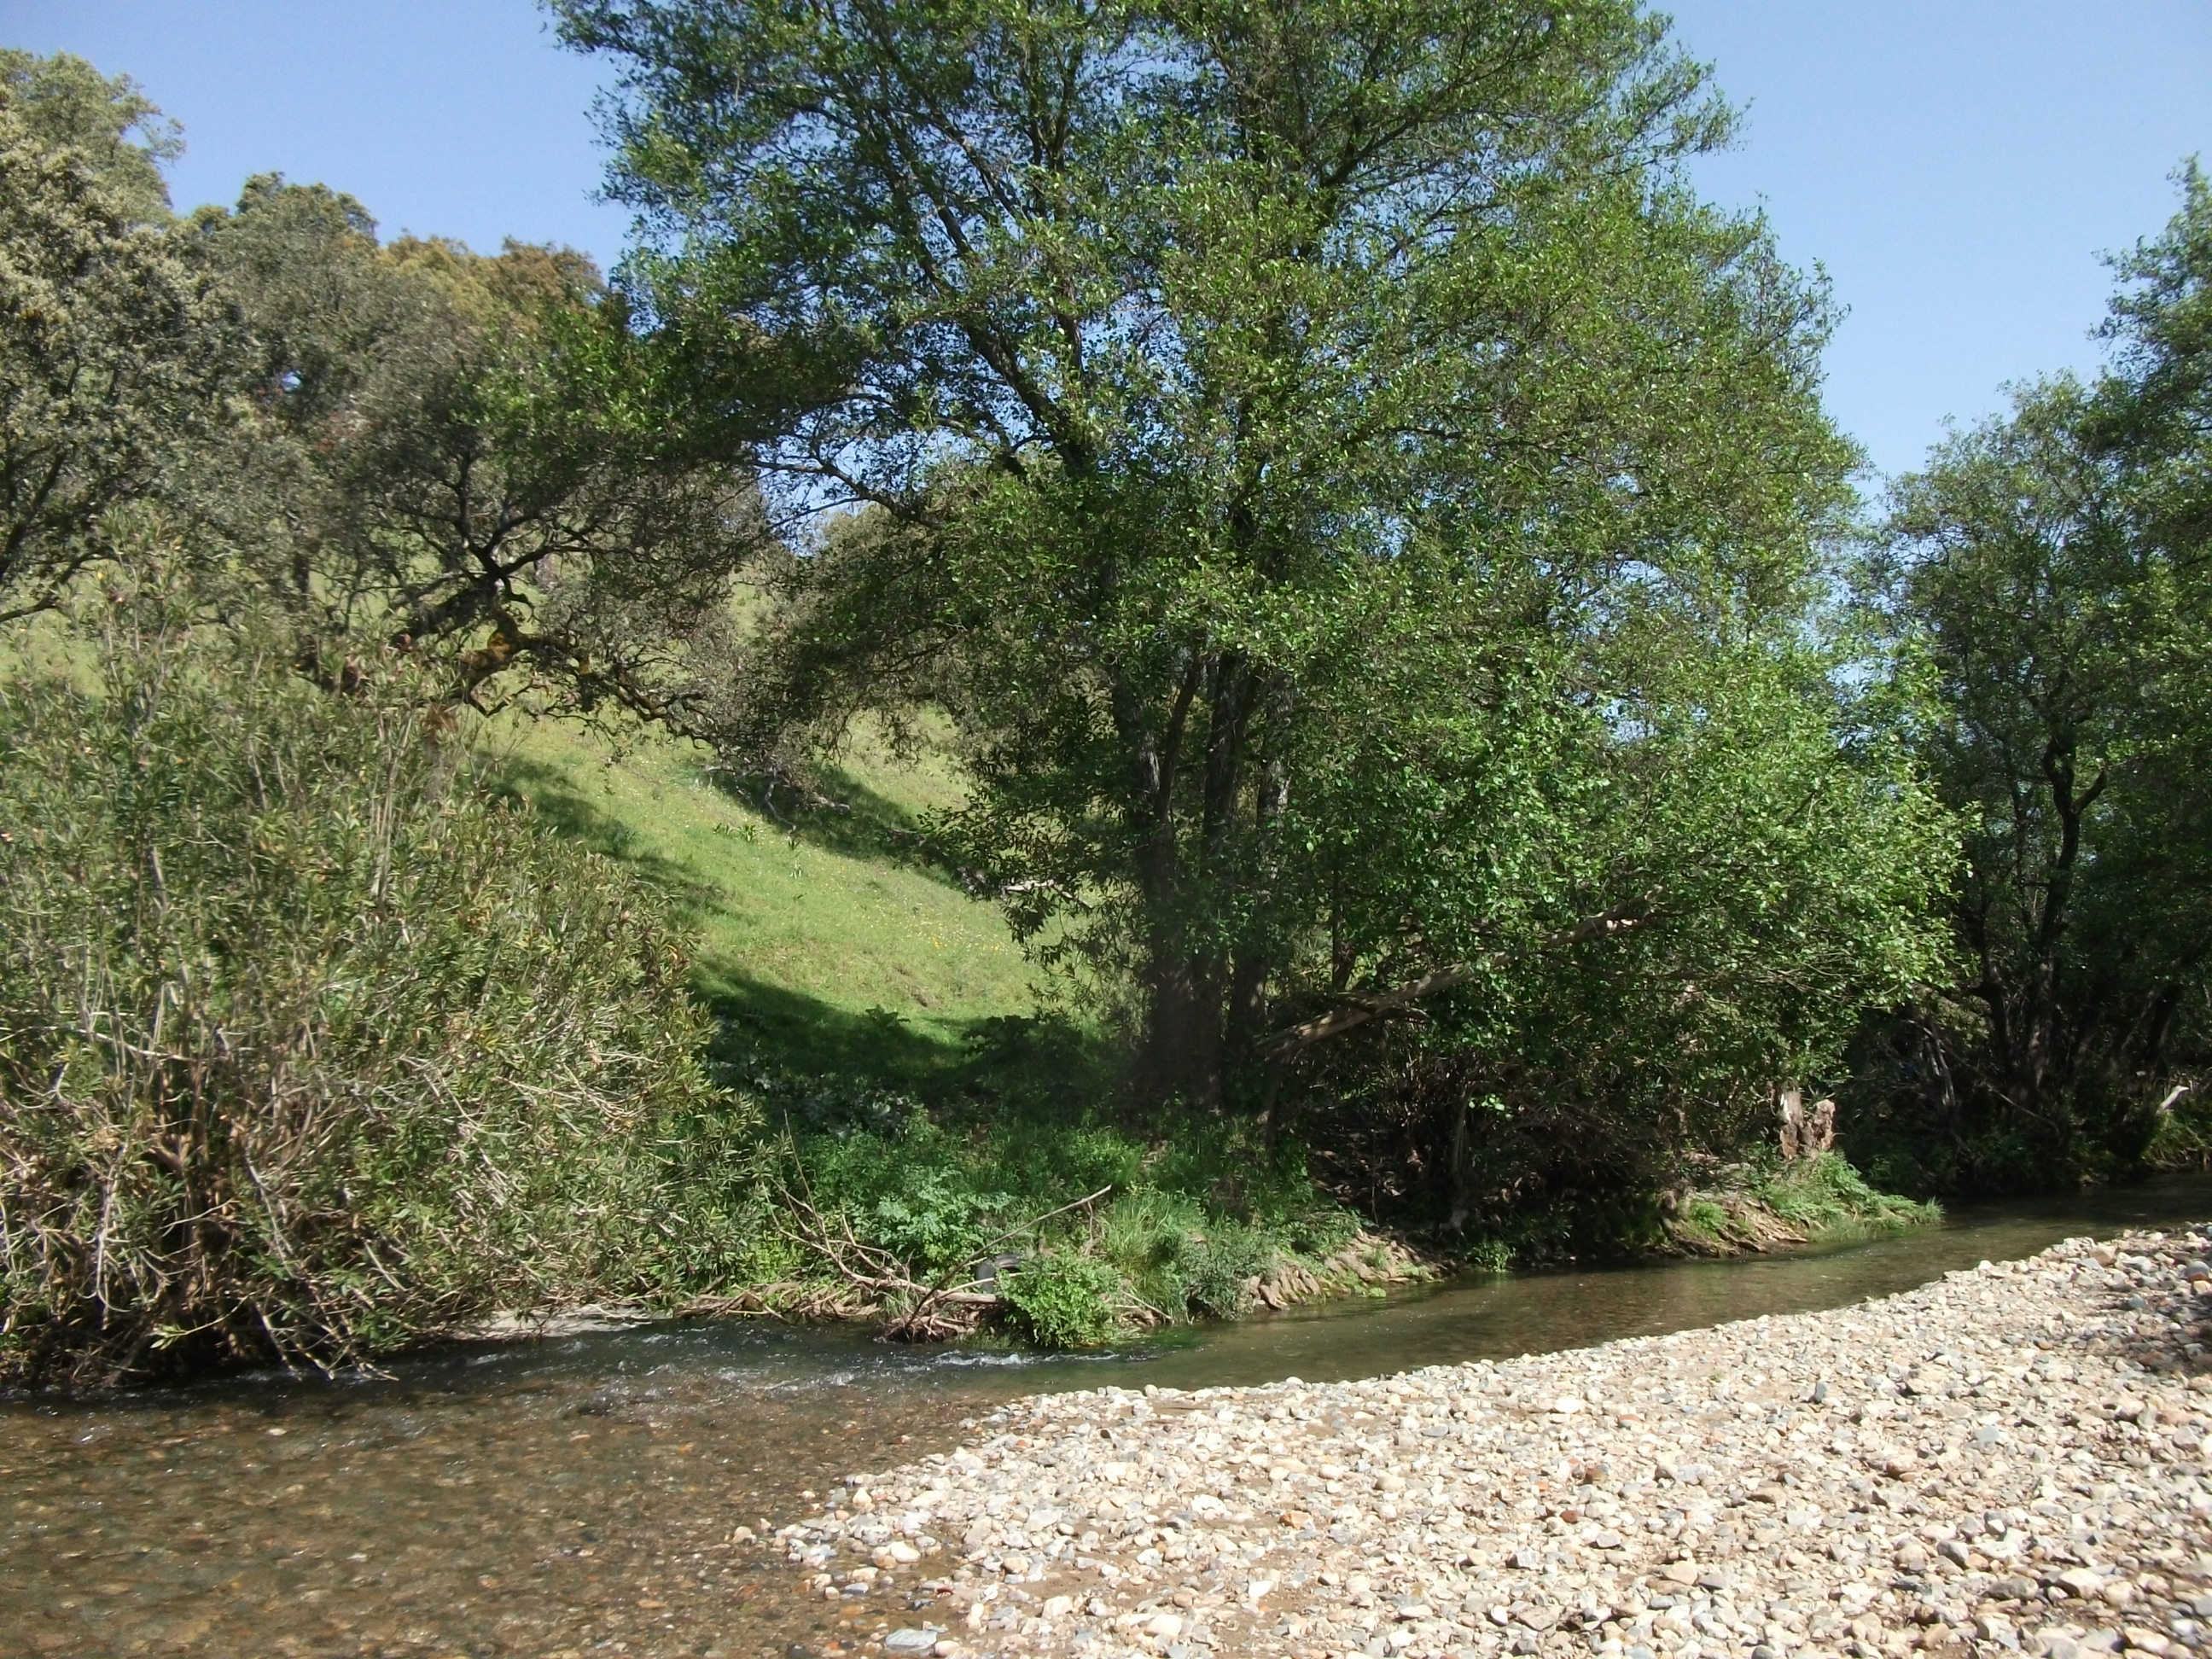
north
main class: Woodland
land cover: Broadleaved woodland
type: broadleaved evergreen forest
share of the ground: 25 - 50 %
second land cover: Grassland without tree/shrub cover
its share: > 75 %
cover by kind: herbaceous plants 60 %, broadleaved forest trees 40 %
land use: Forestry
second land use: Agriculture (excluding fallow land and kitchen gardens)
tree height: > 5 m
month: April
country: ES
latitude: 37.9855
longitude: -6.7516
